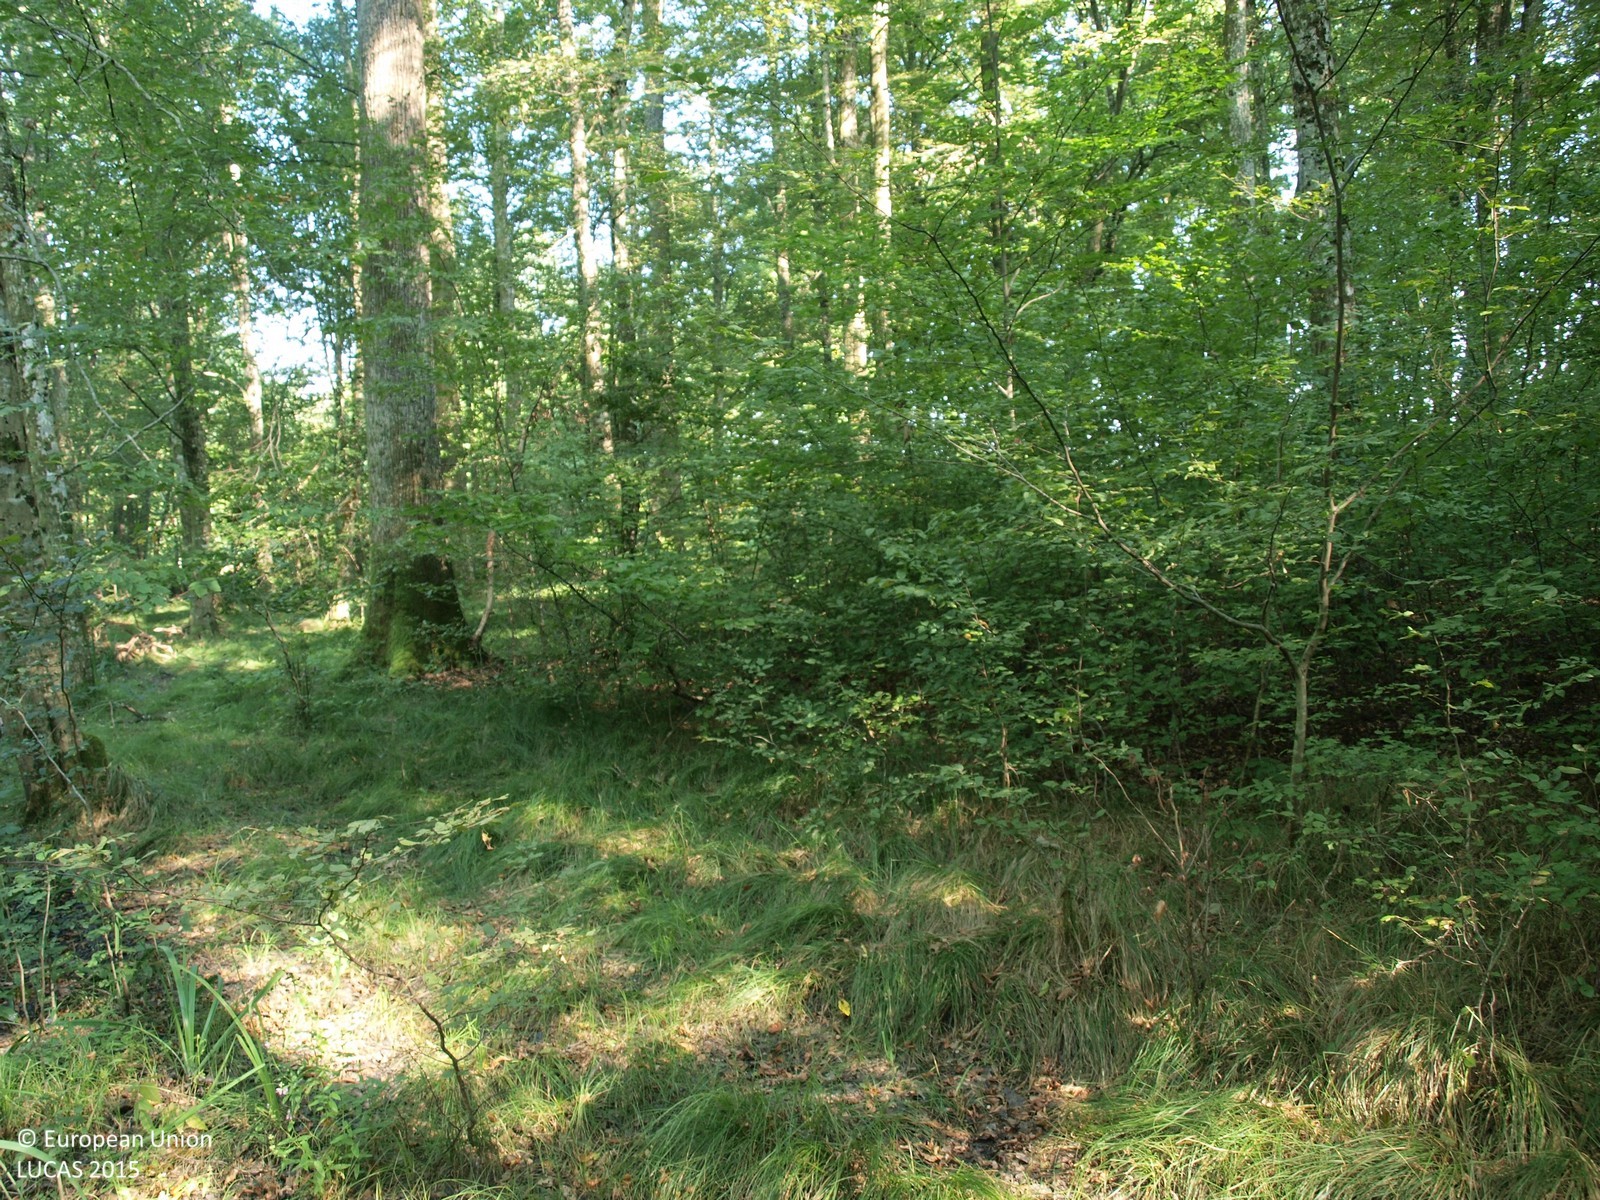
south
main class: Woodland
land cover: Broadleaved woodland
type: floodplain forest
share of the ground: > 75 %
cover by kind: broadleaved forest trees 100 %
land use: Forestry
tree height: > 5 m
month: August
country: HR
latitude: 45.6324
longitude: 16.4508
